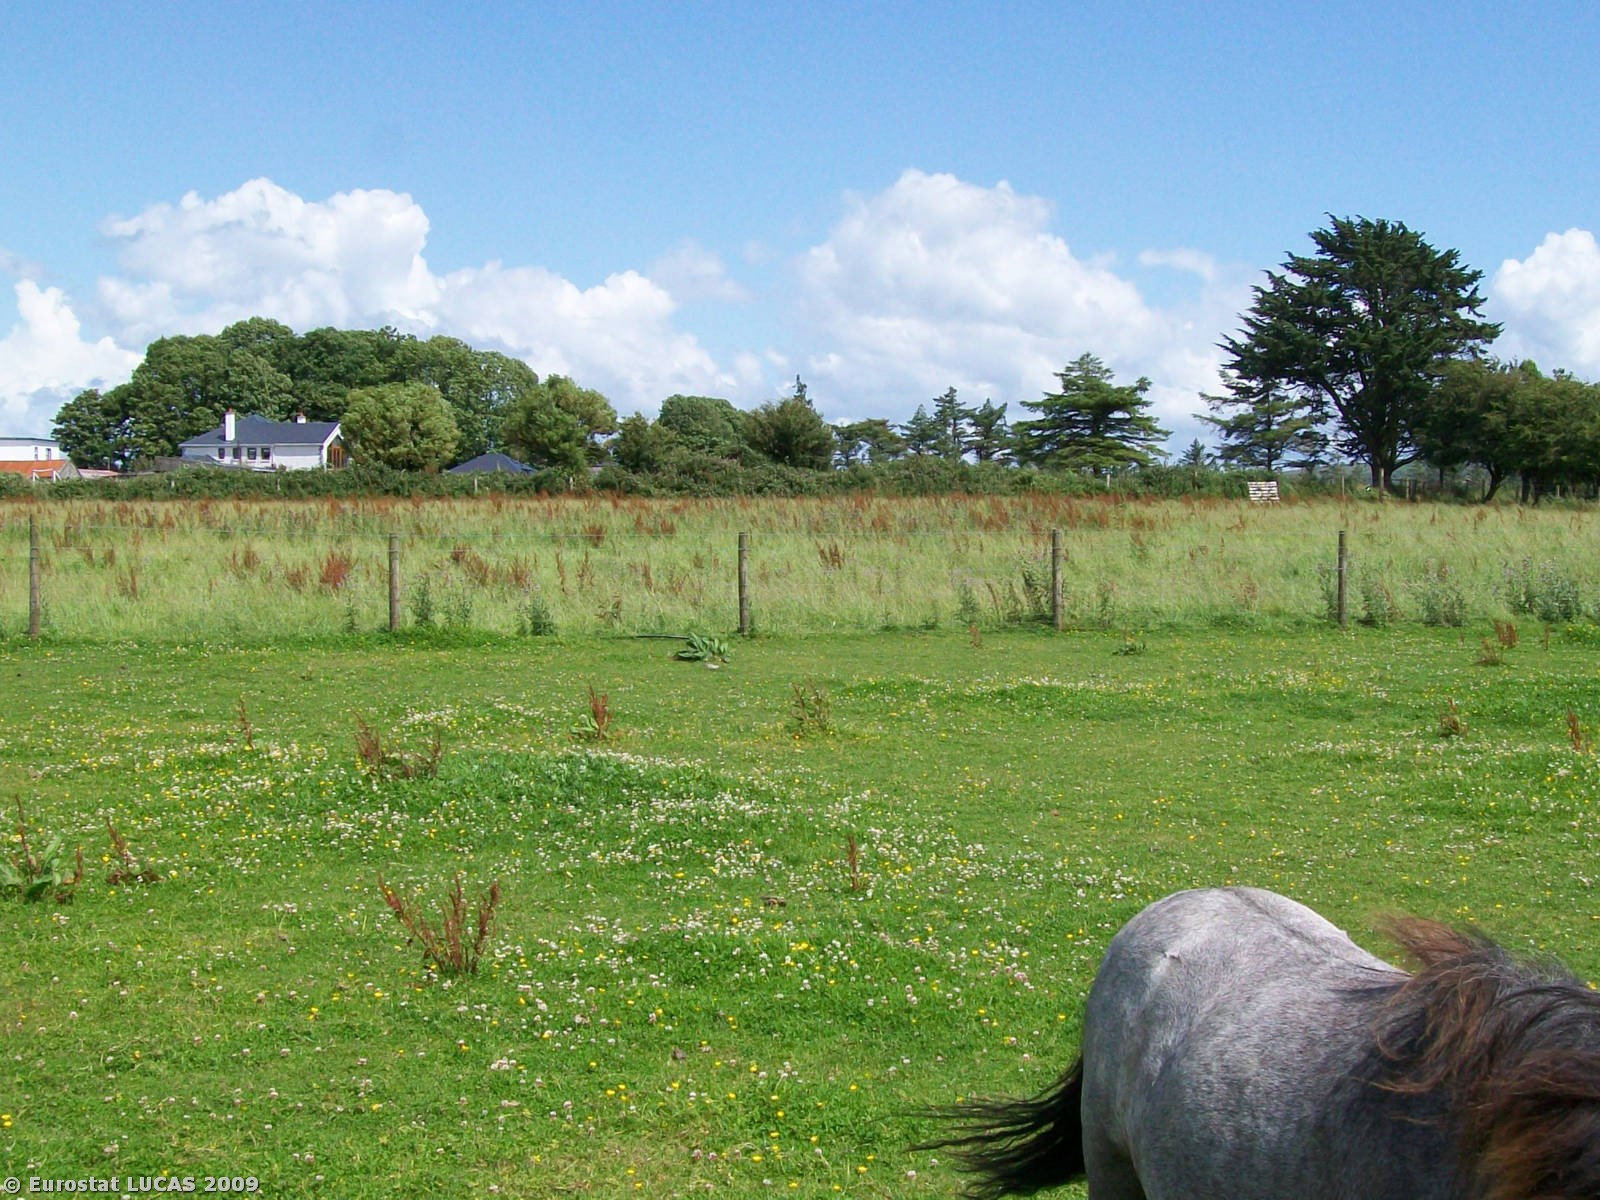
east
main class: Grassland
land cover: Grassland without tree/shrub cover
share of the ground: > 75 %
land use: Agriculture (excluding fallow land and kitchen gardens)
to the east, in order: Grassland without tree/shrub cover; Fences; Managed hedges; Grassland without tree/shrub cover; Fences; Managed hedges; Grassland without tree/shrub cover
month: July
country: IE
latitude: 53.1592
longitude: -8.7325
